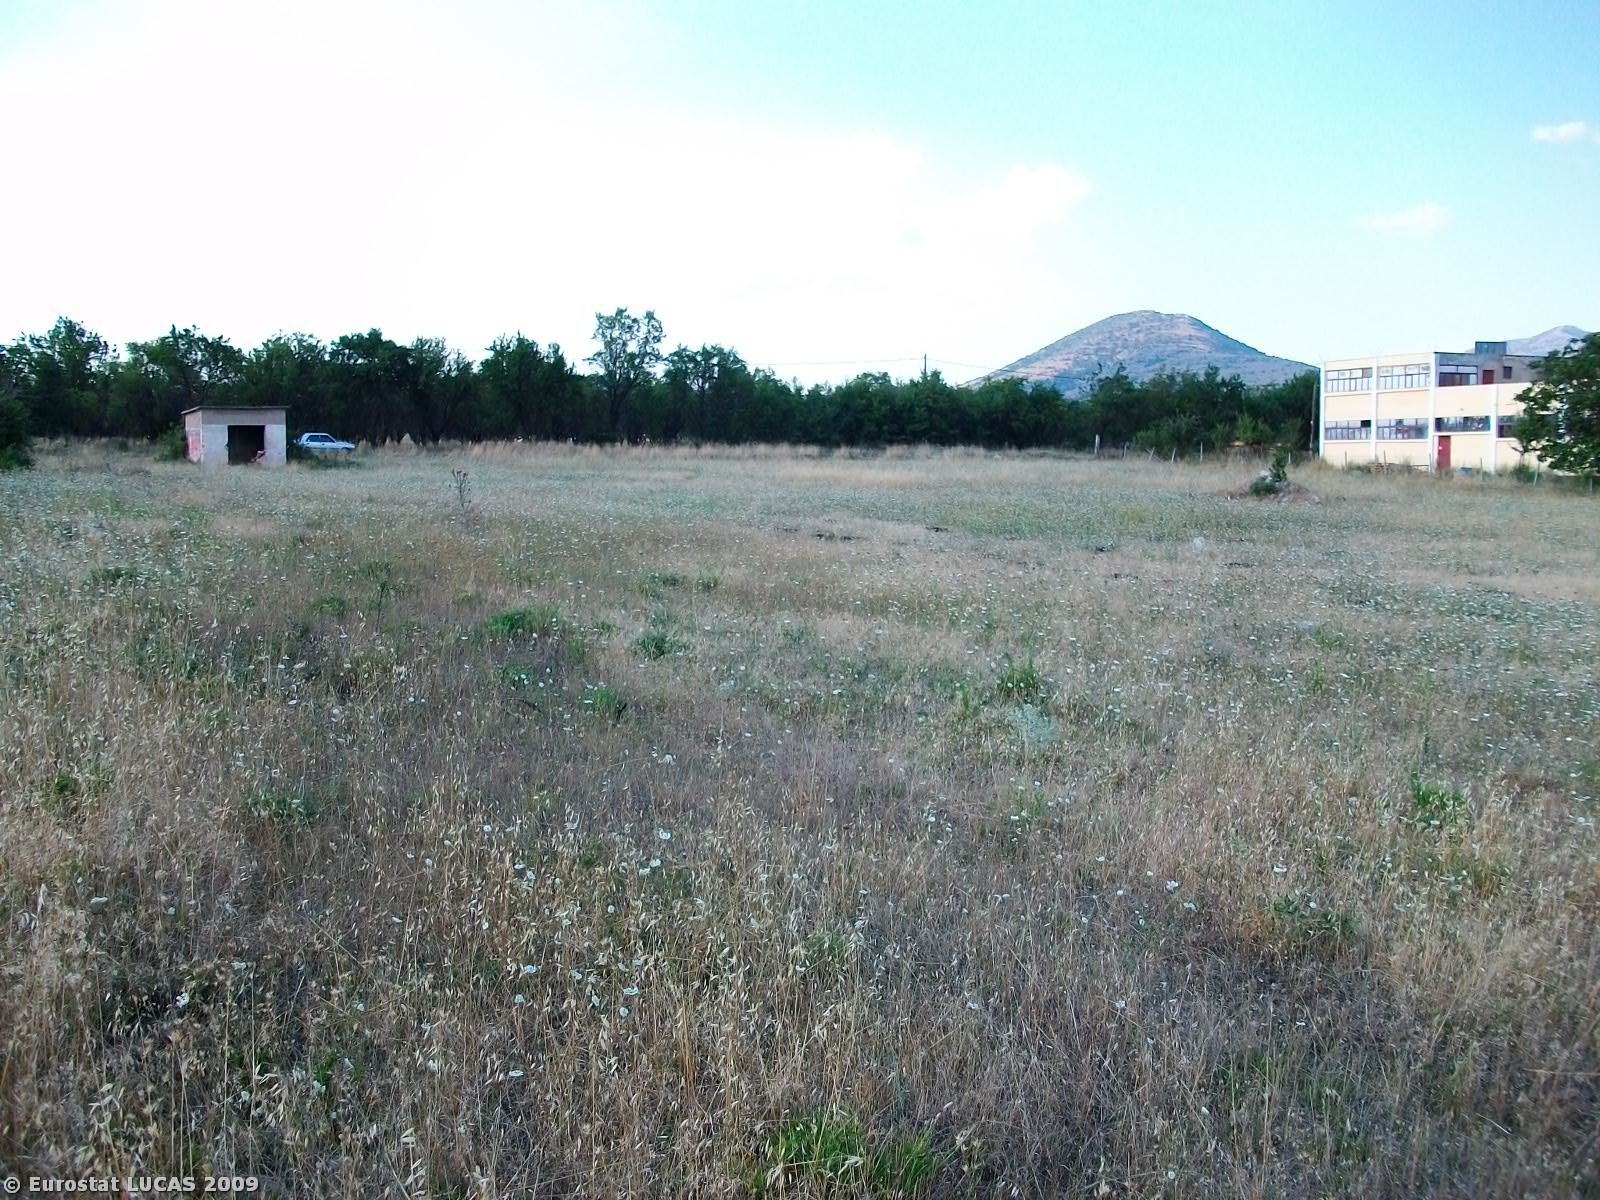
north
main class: Grassland
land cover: Spontaneously vegetated surfaces
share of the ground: > 75 %
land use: Fallow land
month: July
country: GR
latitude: 40.2966
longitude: 21.8389
